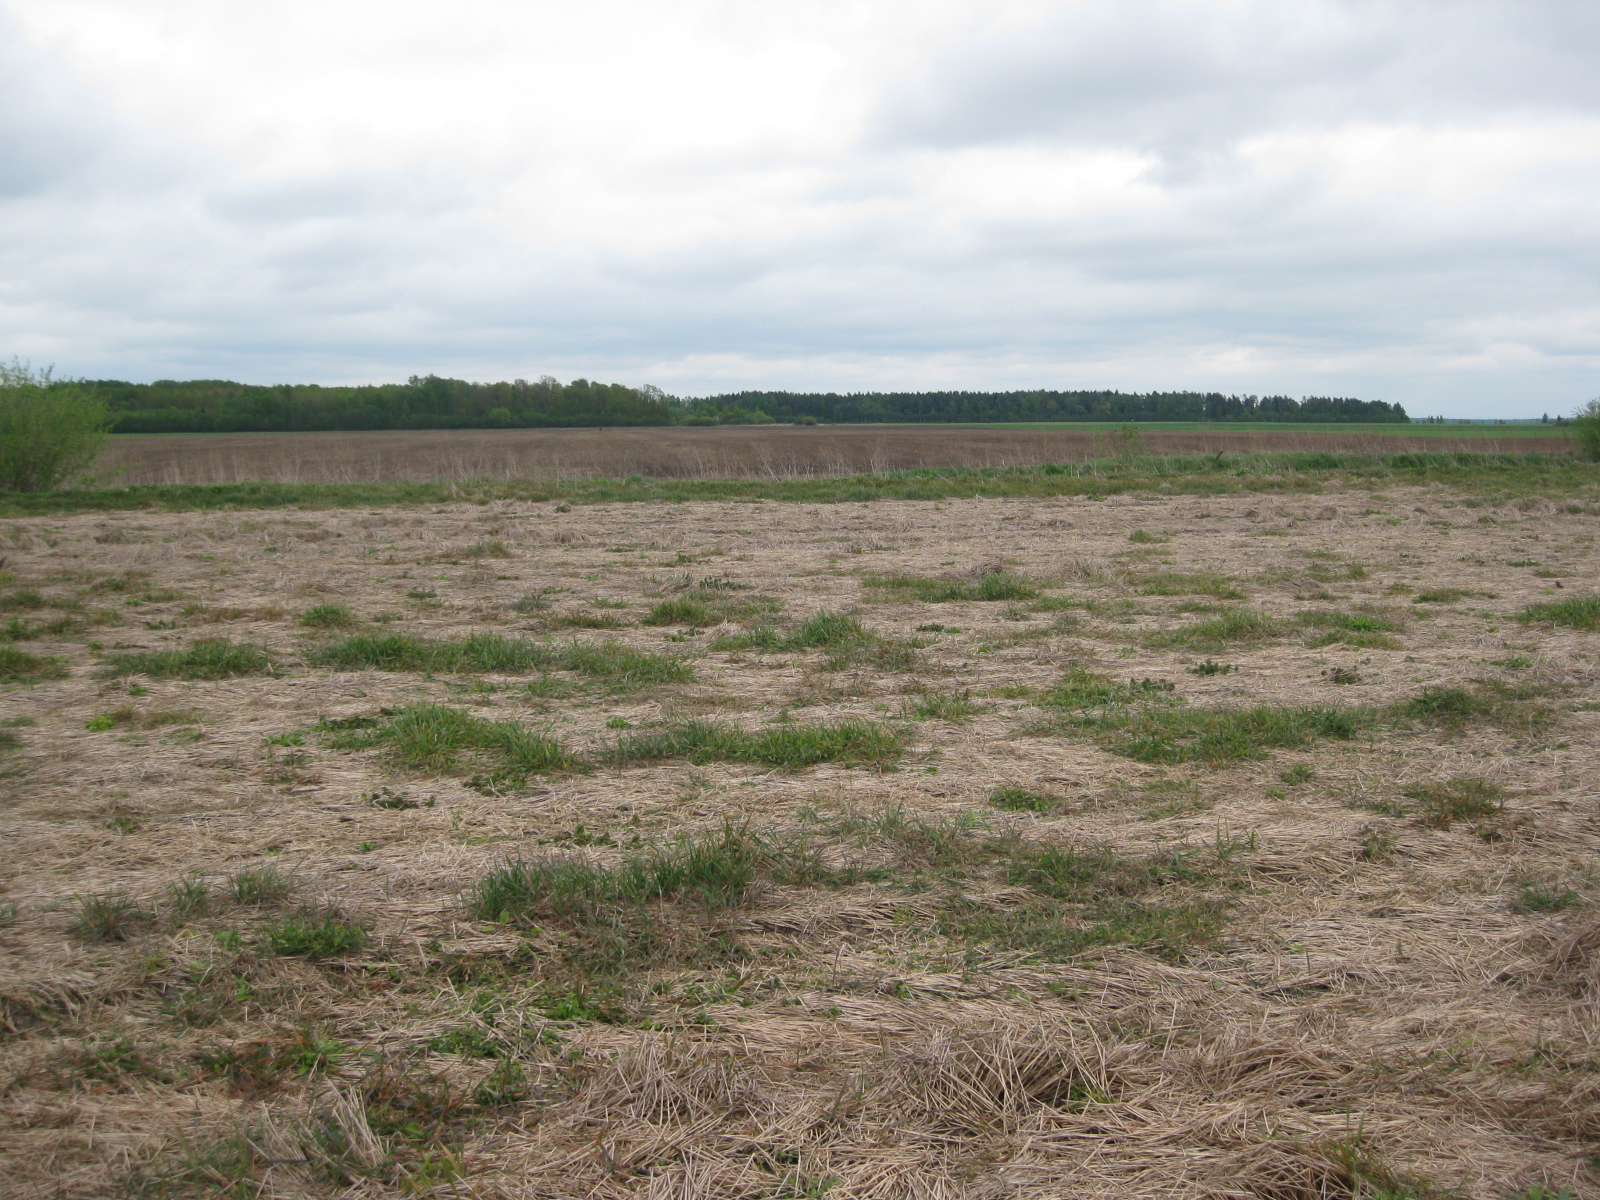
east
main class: Grassland
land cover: Spontaneously vegetated surfaces
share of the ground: 10 - 25 %
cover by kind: unconsolidated bare surface 30 %, herbaceous plants 20 %
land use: Fallow land
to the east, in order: Spontaneously vegetated surfaces; Inland fresh running water; Grassland with sparse tree/shrub cover; Common wheat
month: May
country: LT
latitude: 55.9413
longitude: 24.3606
